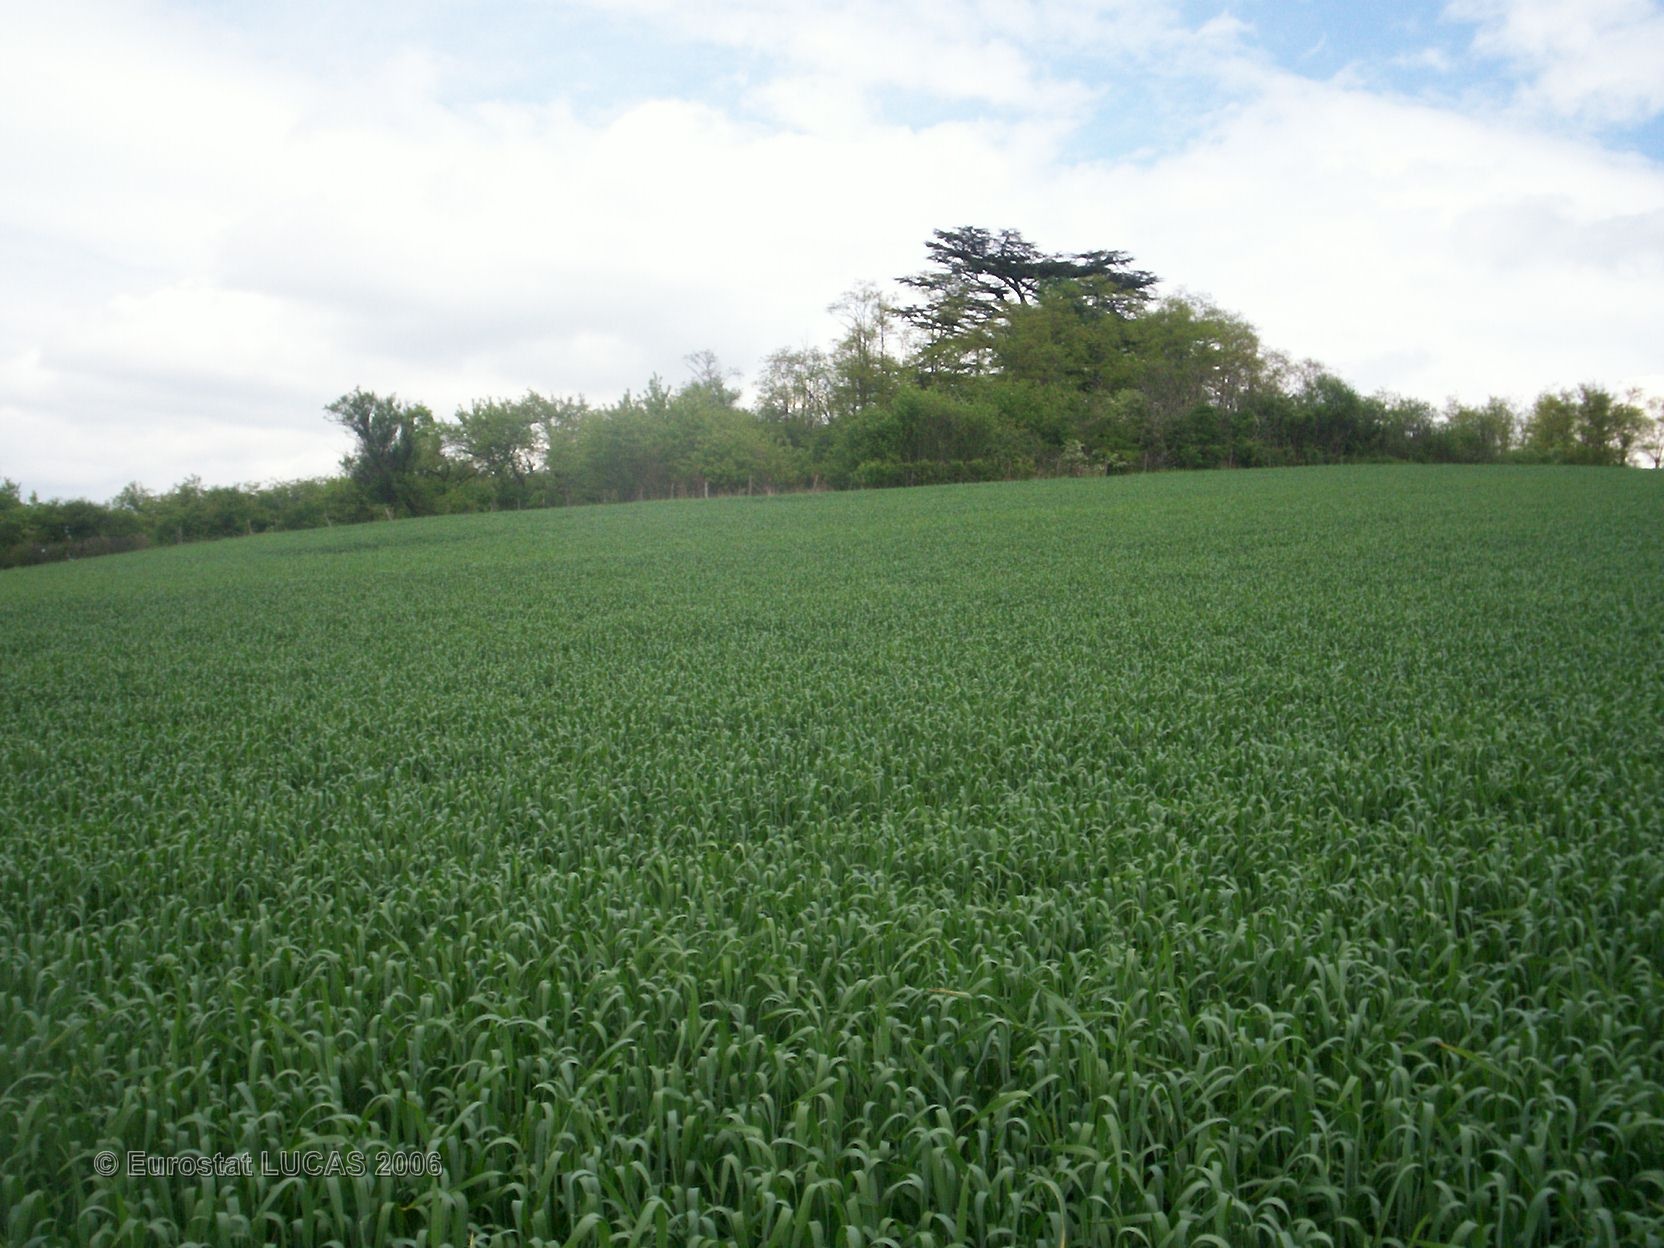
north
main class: Cropland
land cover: Common wheat
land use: Agriculture (excluding fallow land and kitchen gardens)
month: May
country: FR
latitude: 45.6279
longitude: 3.1895
